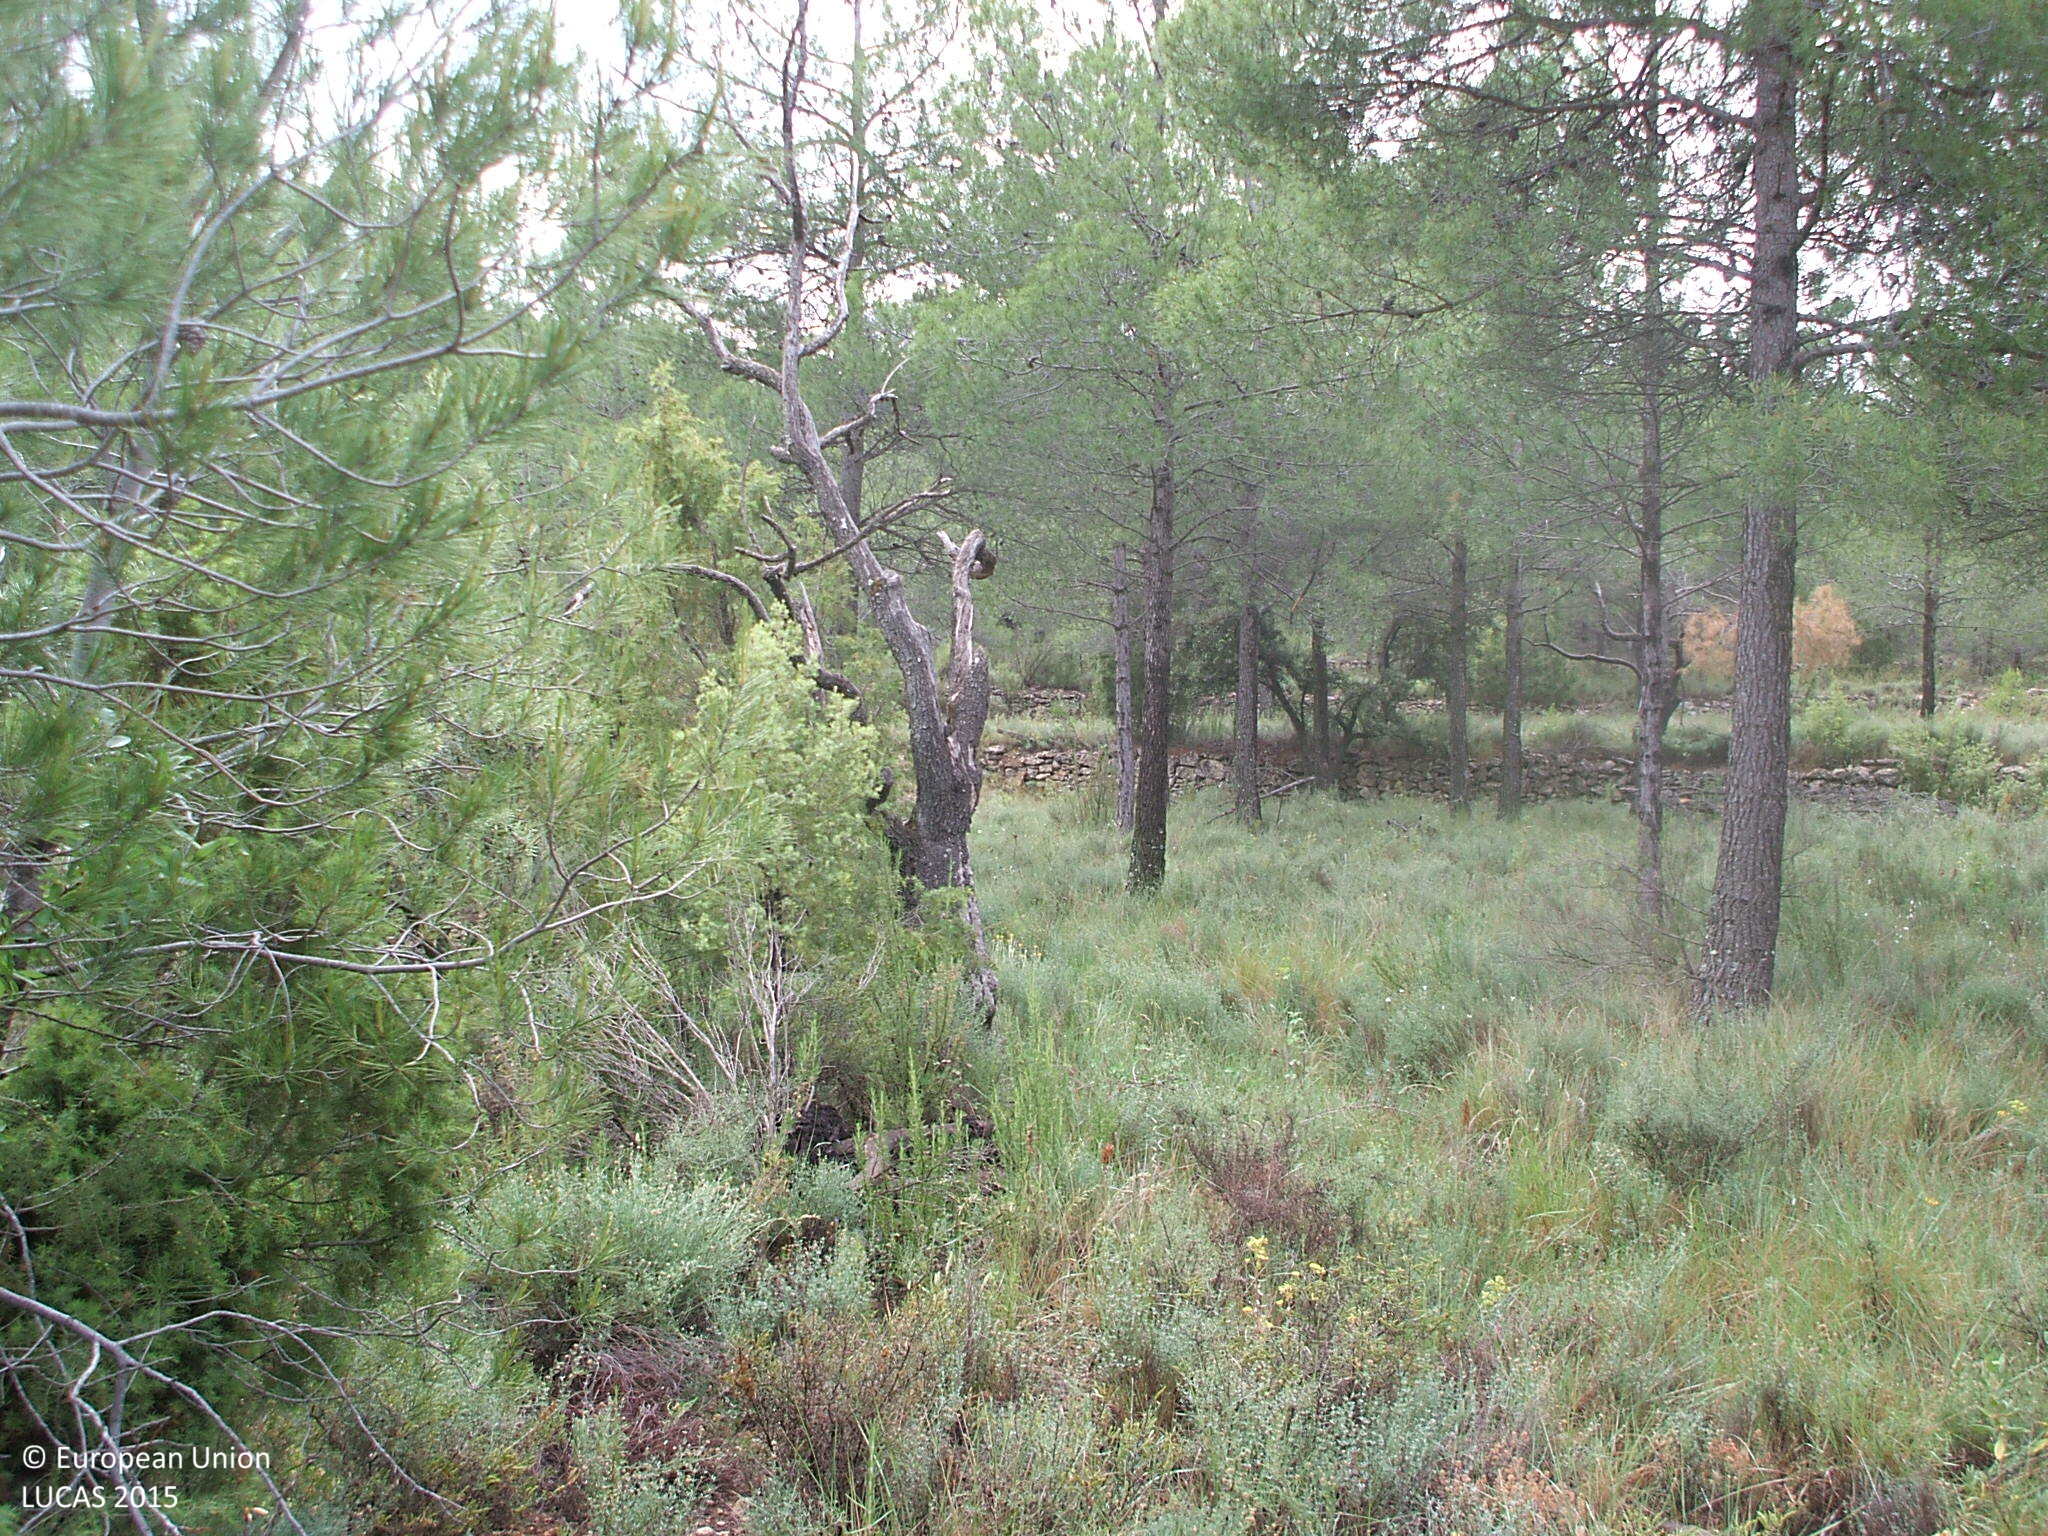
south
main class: Woodland
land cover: Pine dominated coniferous woodland
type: coniferous forest of the mediterranean region
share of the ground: 25 - 50 %
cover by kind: shrubs 70 %, coniferous forest trees 30 %
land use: Semi-natural and natural areas not in use
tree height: > 5 m
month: June
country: ES
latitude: 40.8674
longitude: 0.0128
